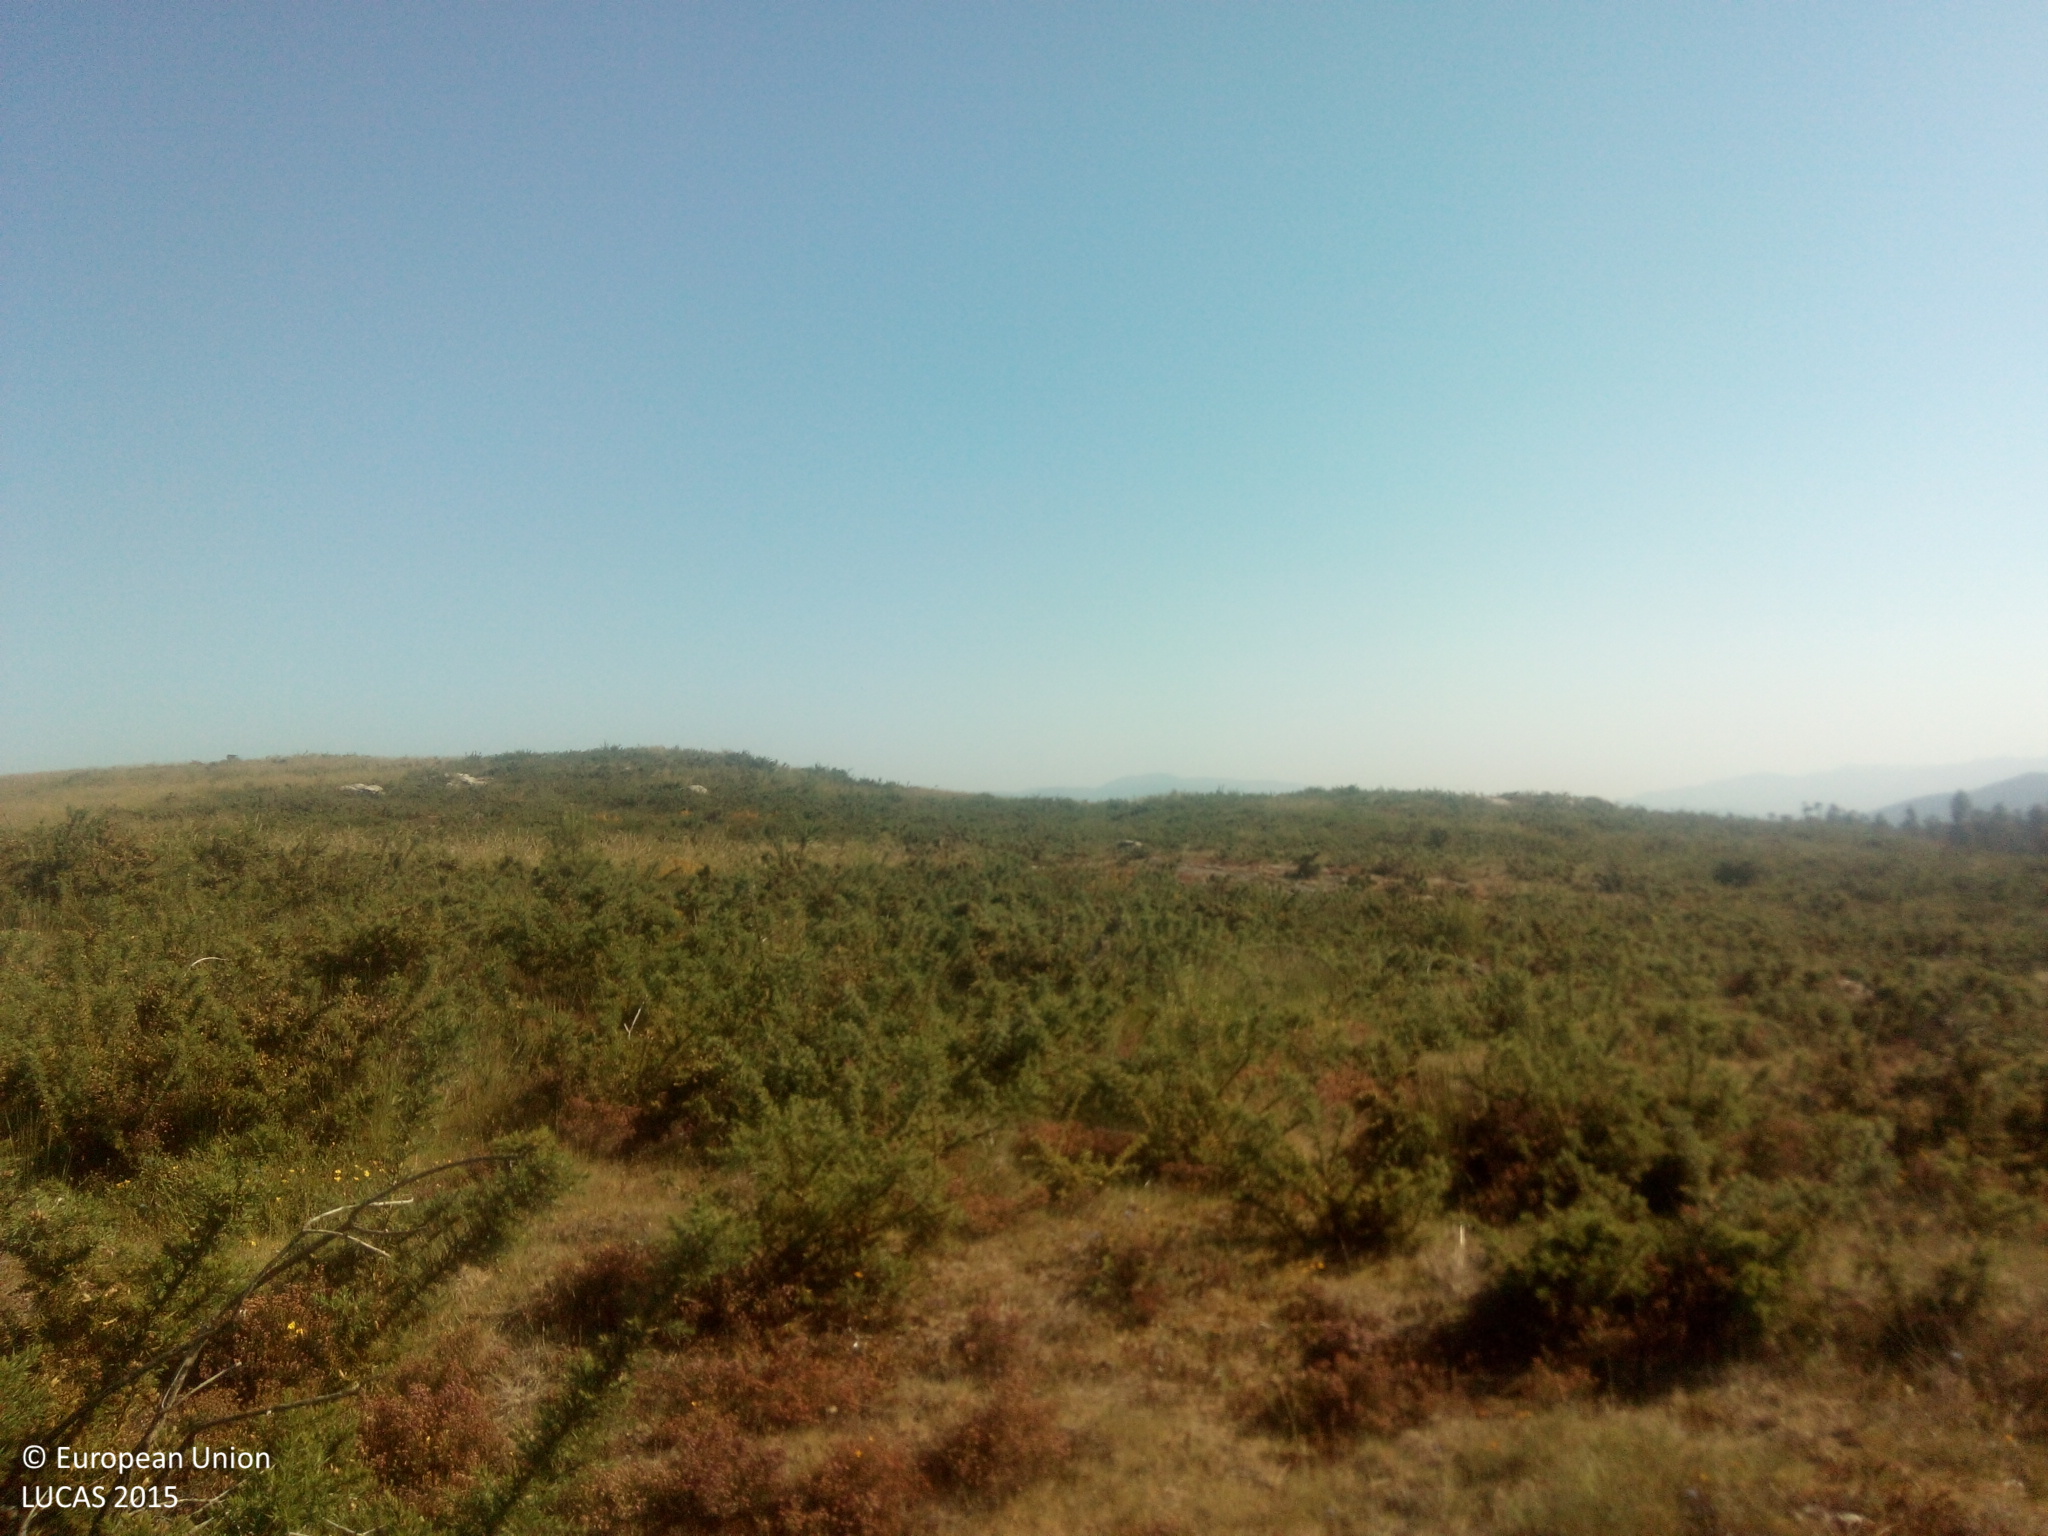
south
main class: Shrubland
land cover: Shrubland without tree cover
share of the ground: > 75 %
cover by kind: shrubs 100 %
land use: Semi-natural and natural areas not in use
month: June
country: ES
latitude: 42.1956
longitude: -8.2637
